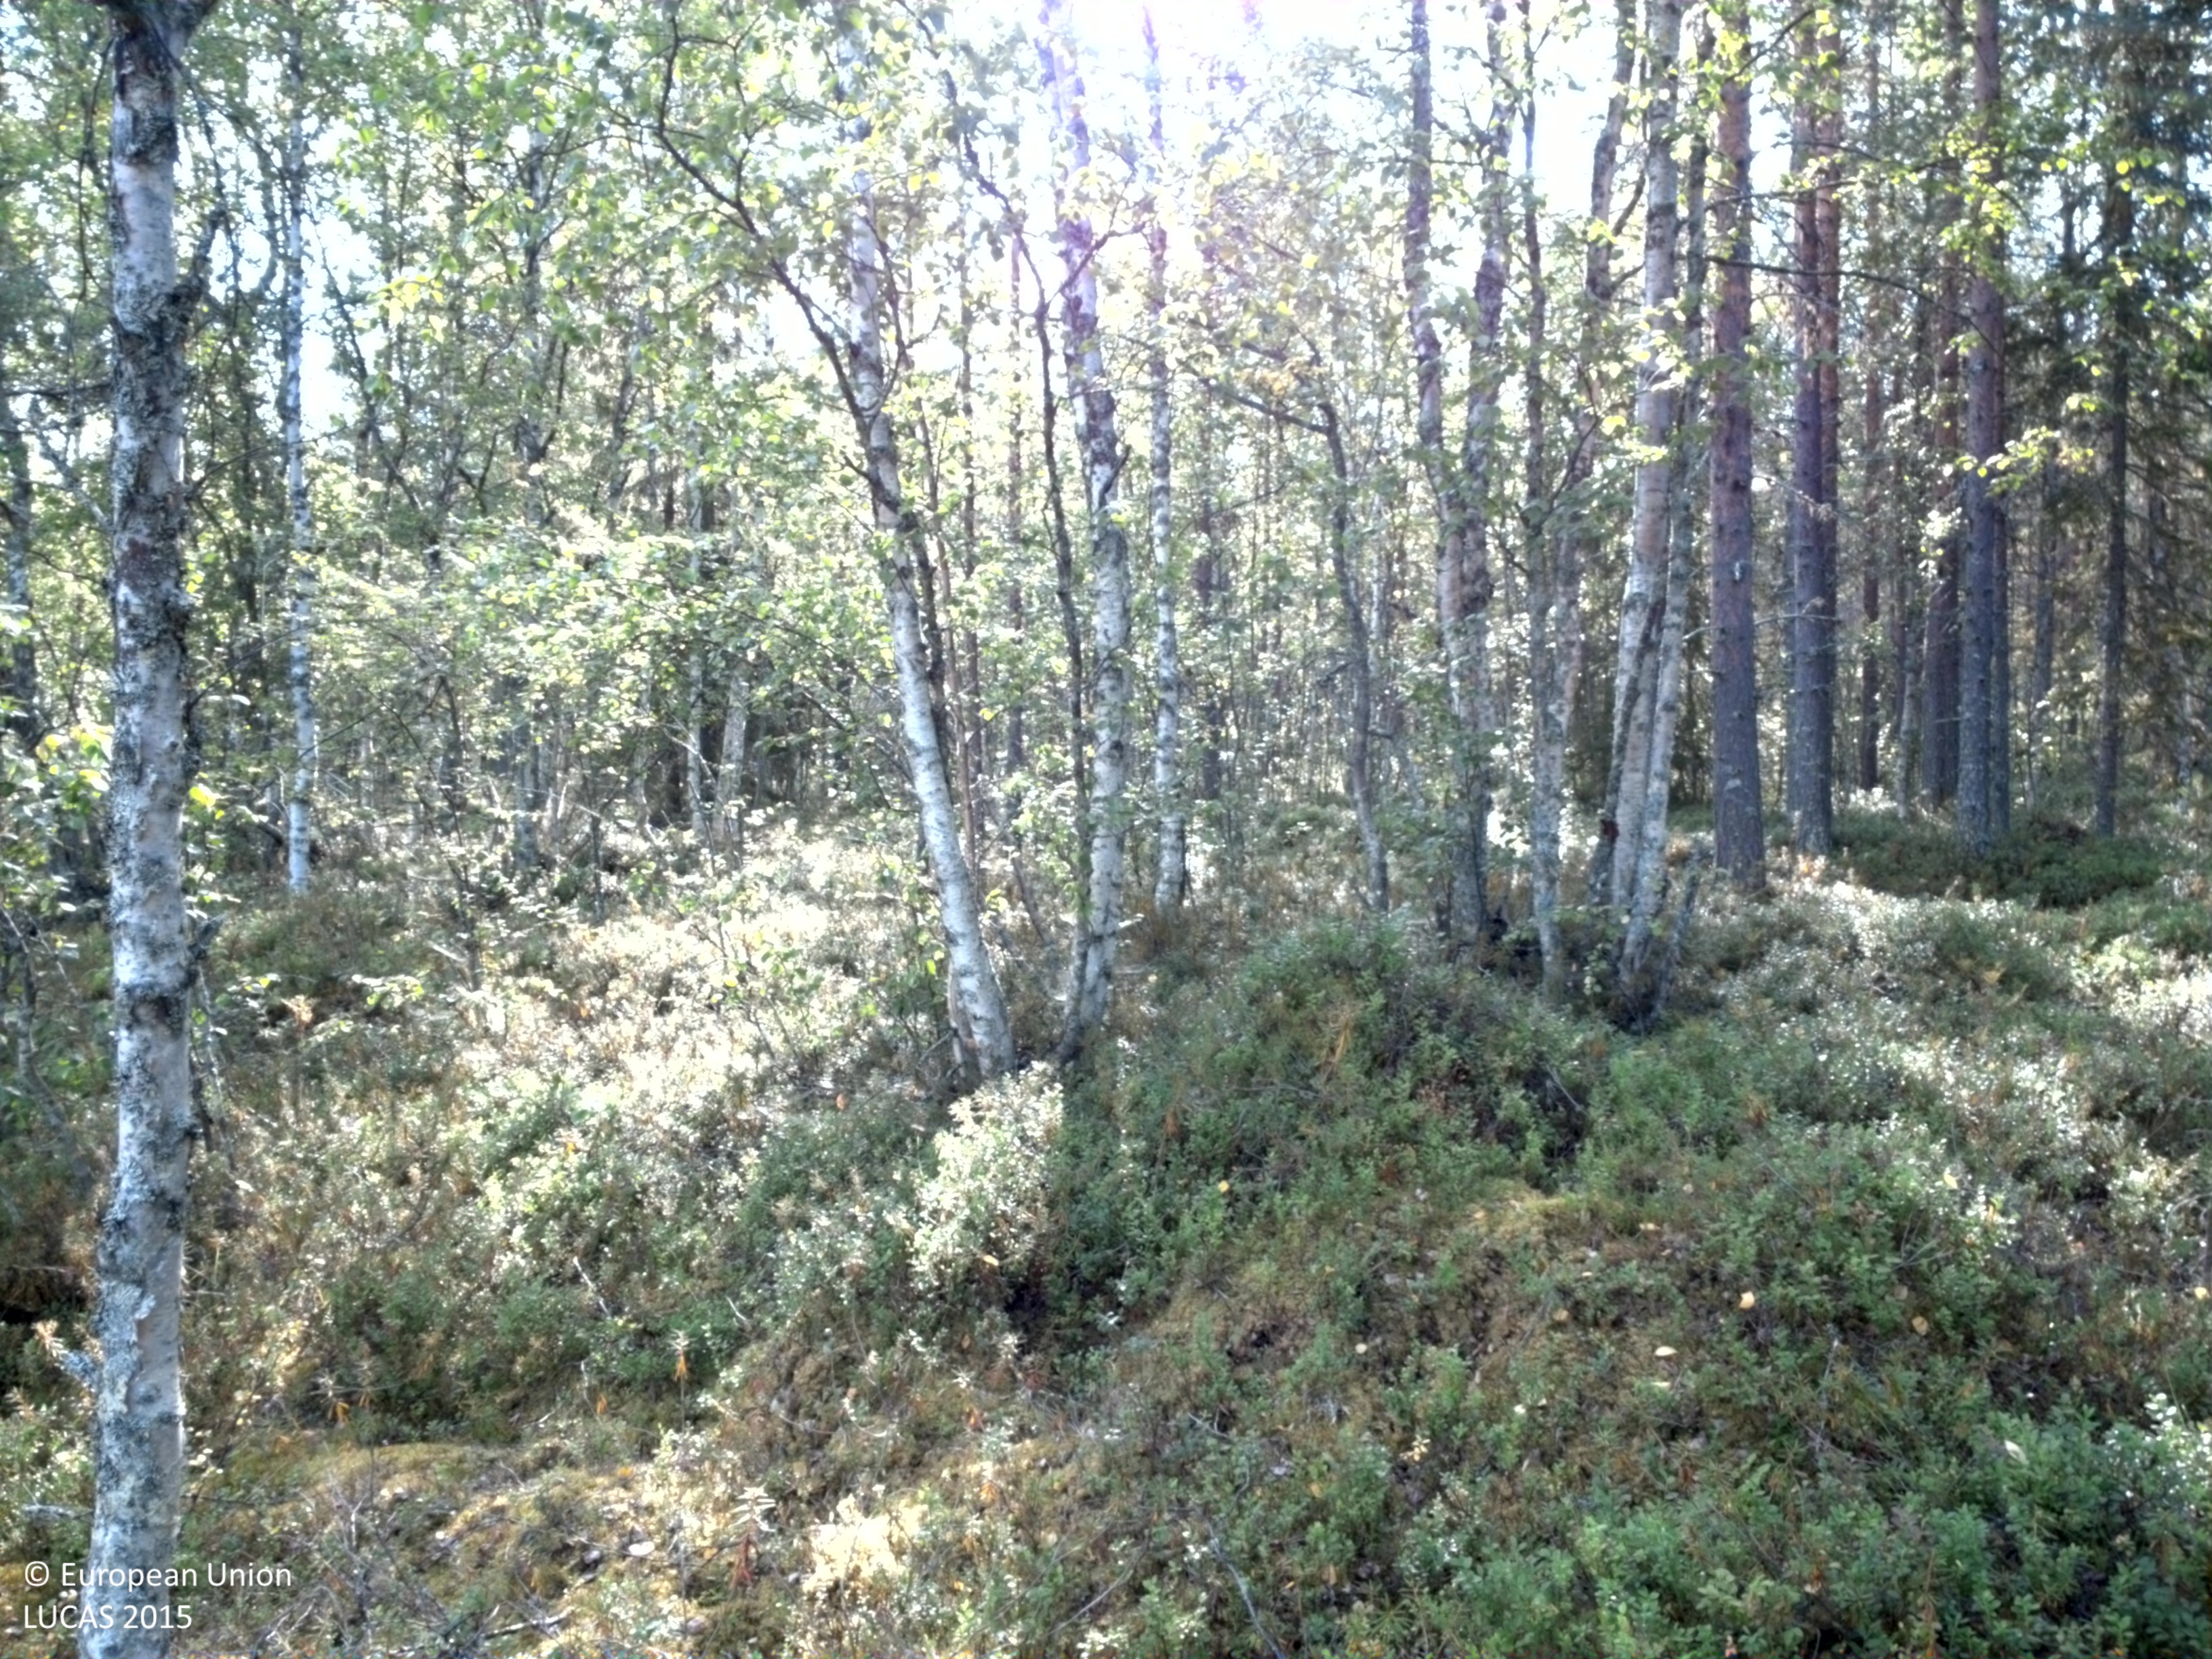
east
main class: Woodland
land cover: Pine dominated mixed woodland
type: boreal forest
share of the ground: 50 - 75 %
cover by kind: coniferous forest trees 45 %, shrubs 30 %, broadleaved forest trees 15 %, lichens and mosses 10 %
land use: Forestry
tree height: > 5 m
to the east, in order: Pine dominated mixed woodland; Pine dominated coniferous woodland; Inland fresh water bodies
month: August
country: SE
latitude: 64.6010
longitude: 18.9329
